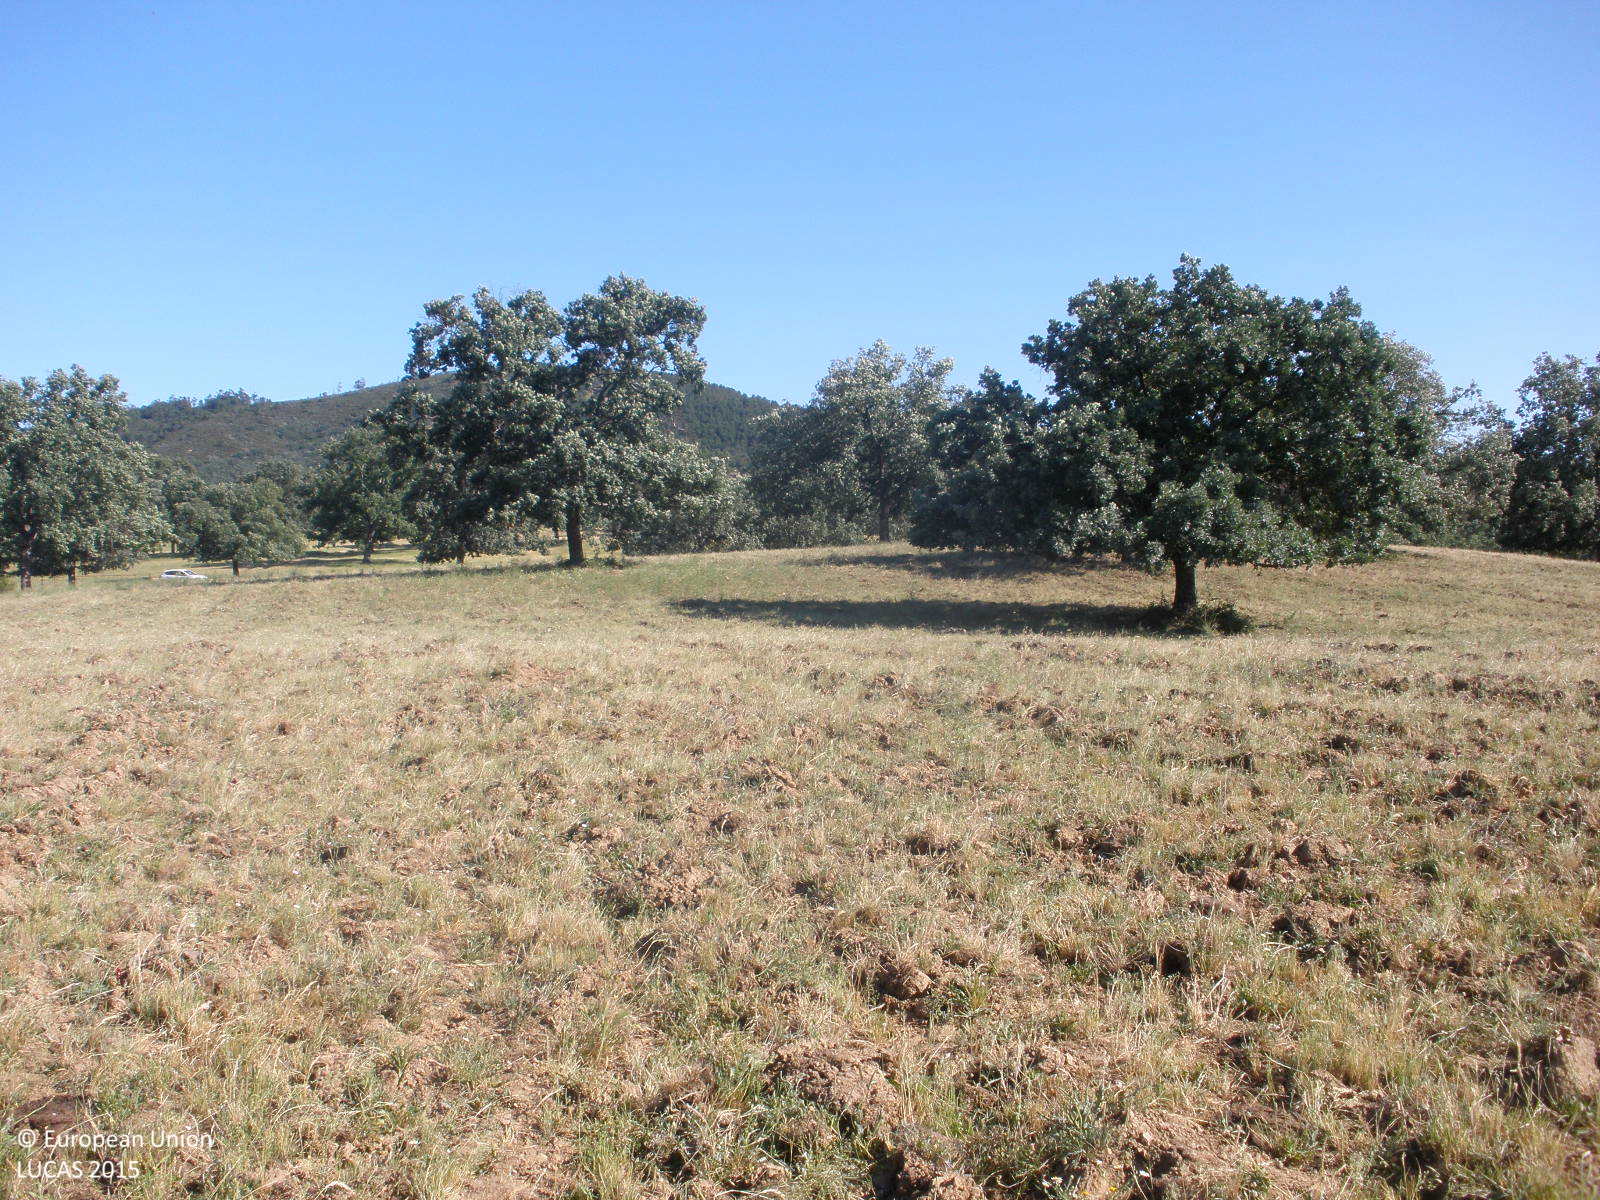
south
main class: Woodland
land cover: Broadleaved woodland
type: broadleaved evergreen forest
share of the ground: 25 - 50 %
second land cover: Spontaneously vegetated surfaces
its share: > 75 %
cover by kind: herbaceous plants 60 %, broadleaved forest trees 30 %, consolidated bare surface 10 %
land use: Forestry
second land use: Agriculture (excluding fallow land and kitchen gardens)
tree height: > 5 m
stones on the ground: 10 - 25 %
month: May
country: ES
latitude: 40.1279
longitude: -6.8350
